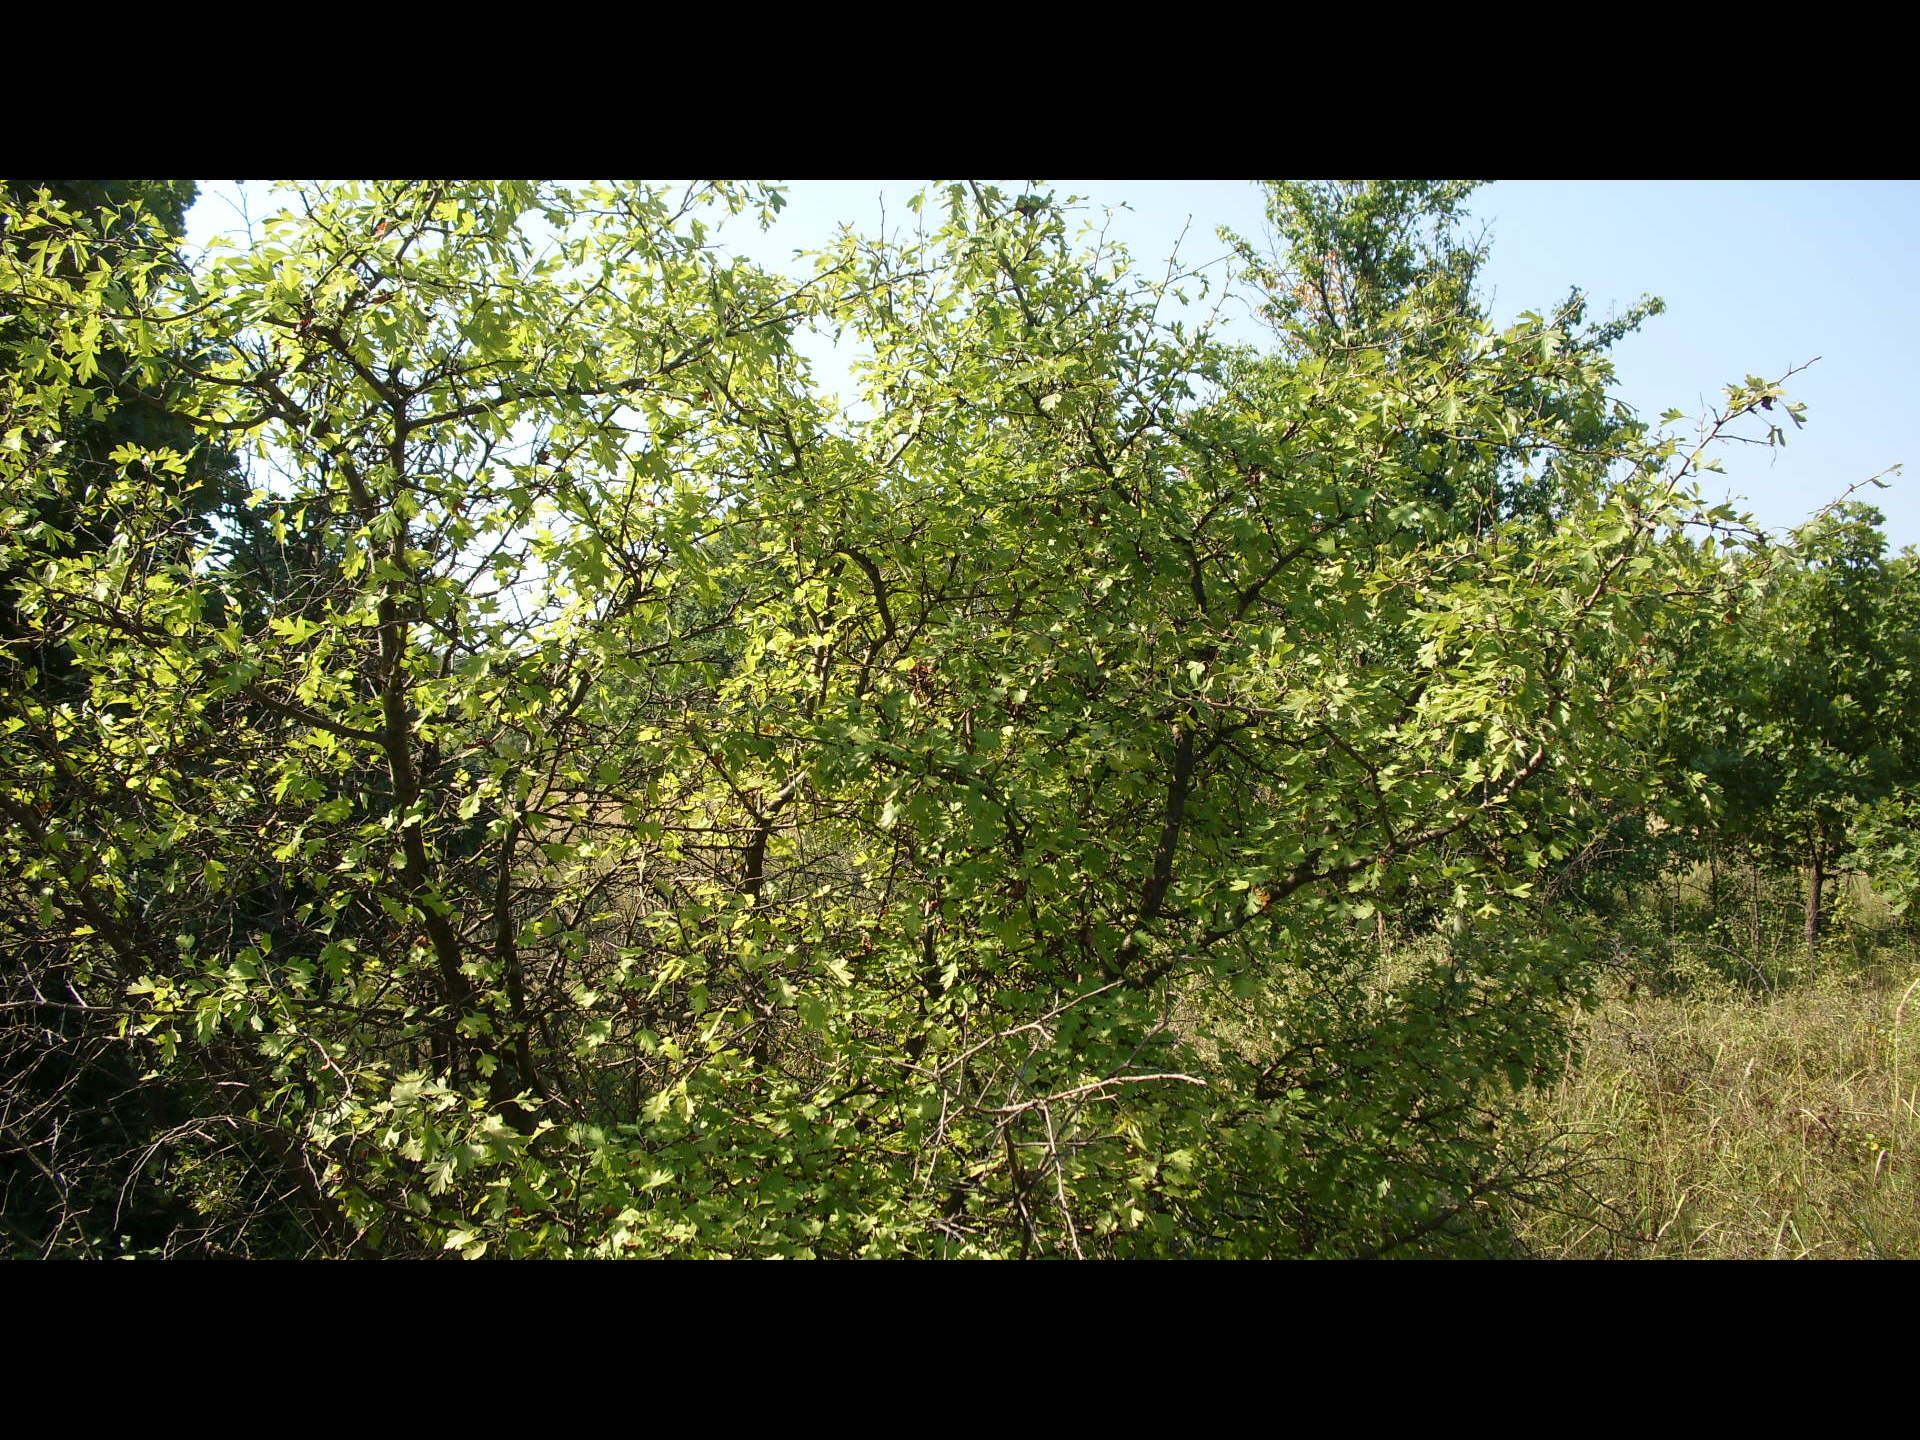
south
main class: Shrubland
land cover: Shrubland with sparse tree cover
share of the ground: > 75 %
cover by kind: shrubs 80 %, herbaceous plants 15 %, broadleaved forest trees 5 %
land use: Semi-natural and natural areas not in use
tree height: < 5 m
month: September
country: BG
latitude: 44.0556
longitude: 22.5810
